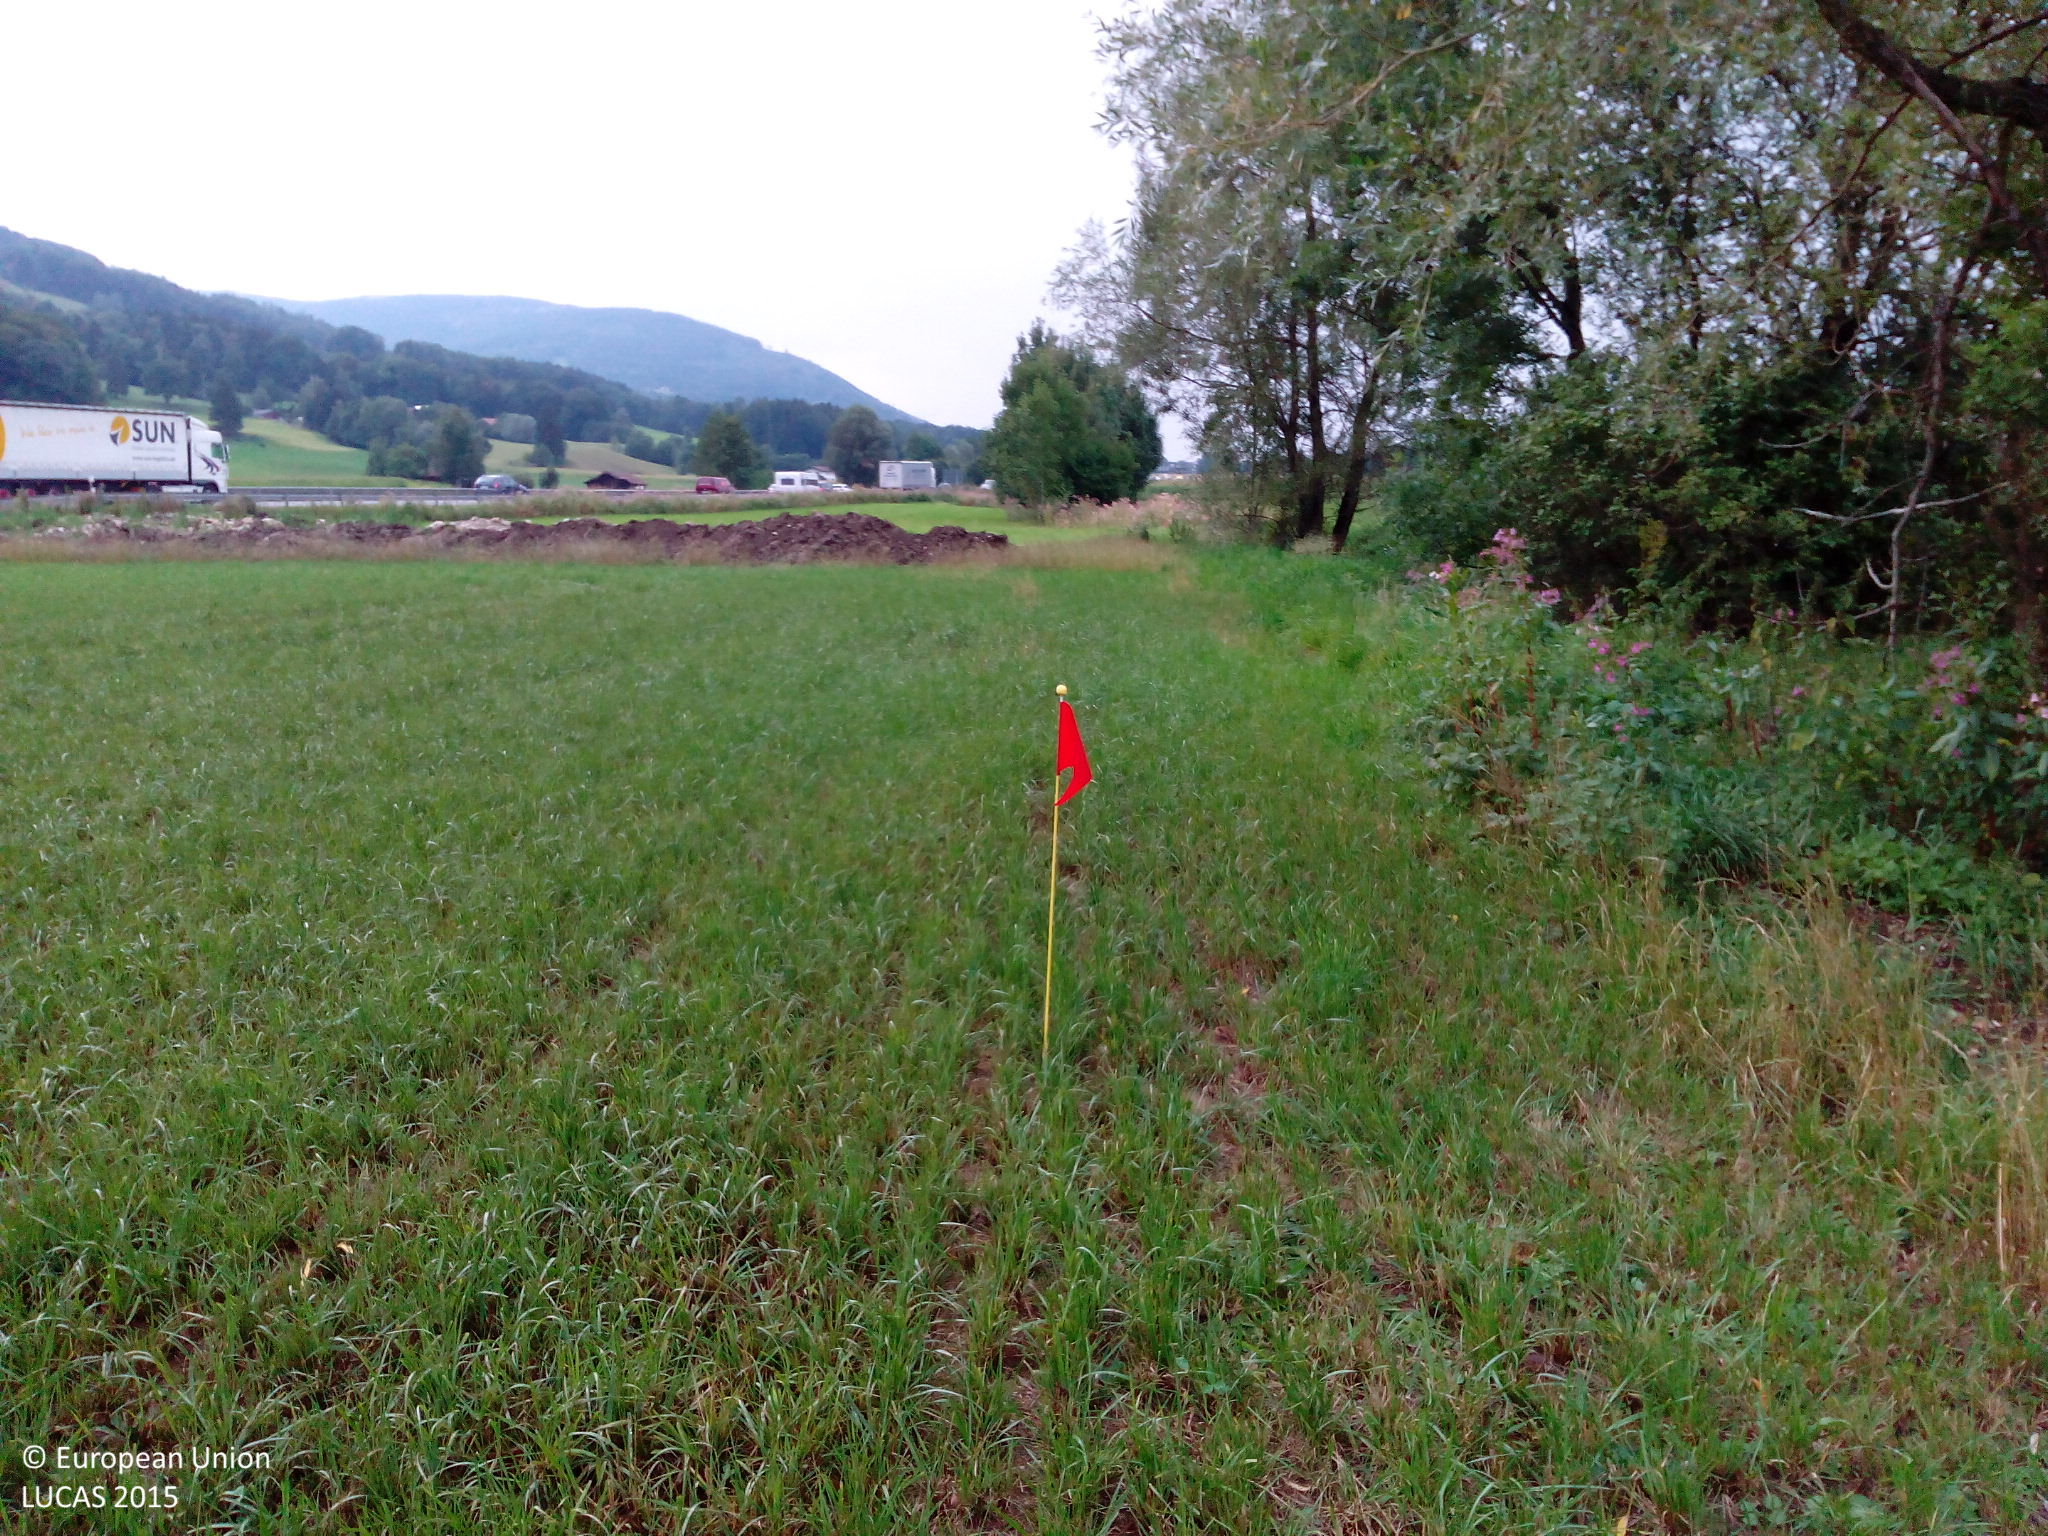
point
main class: Cropland
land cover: Temporary grasslands
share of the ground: 50 - 75 %
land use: Agriculture (excluding fallow land and kitchen gardens)
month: August
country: DE
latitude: 47.7901
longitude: 12.8686
